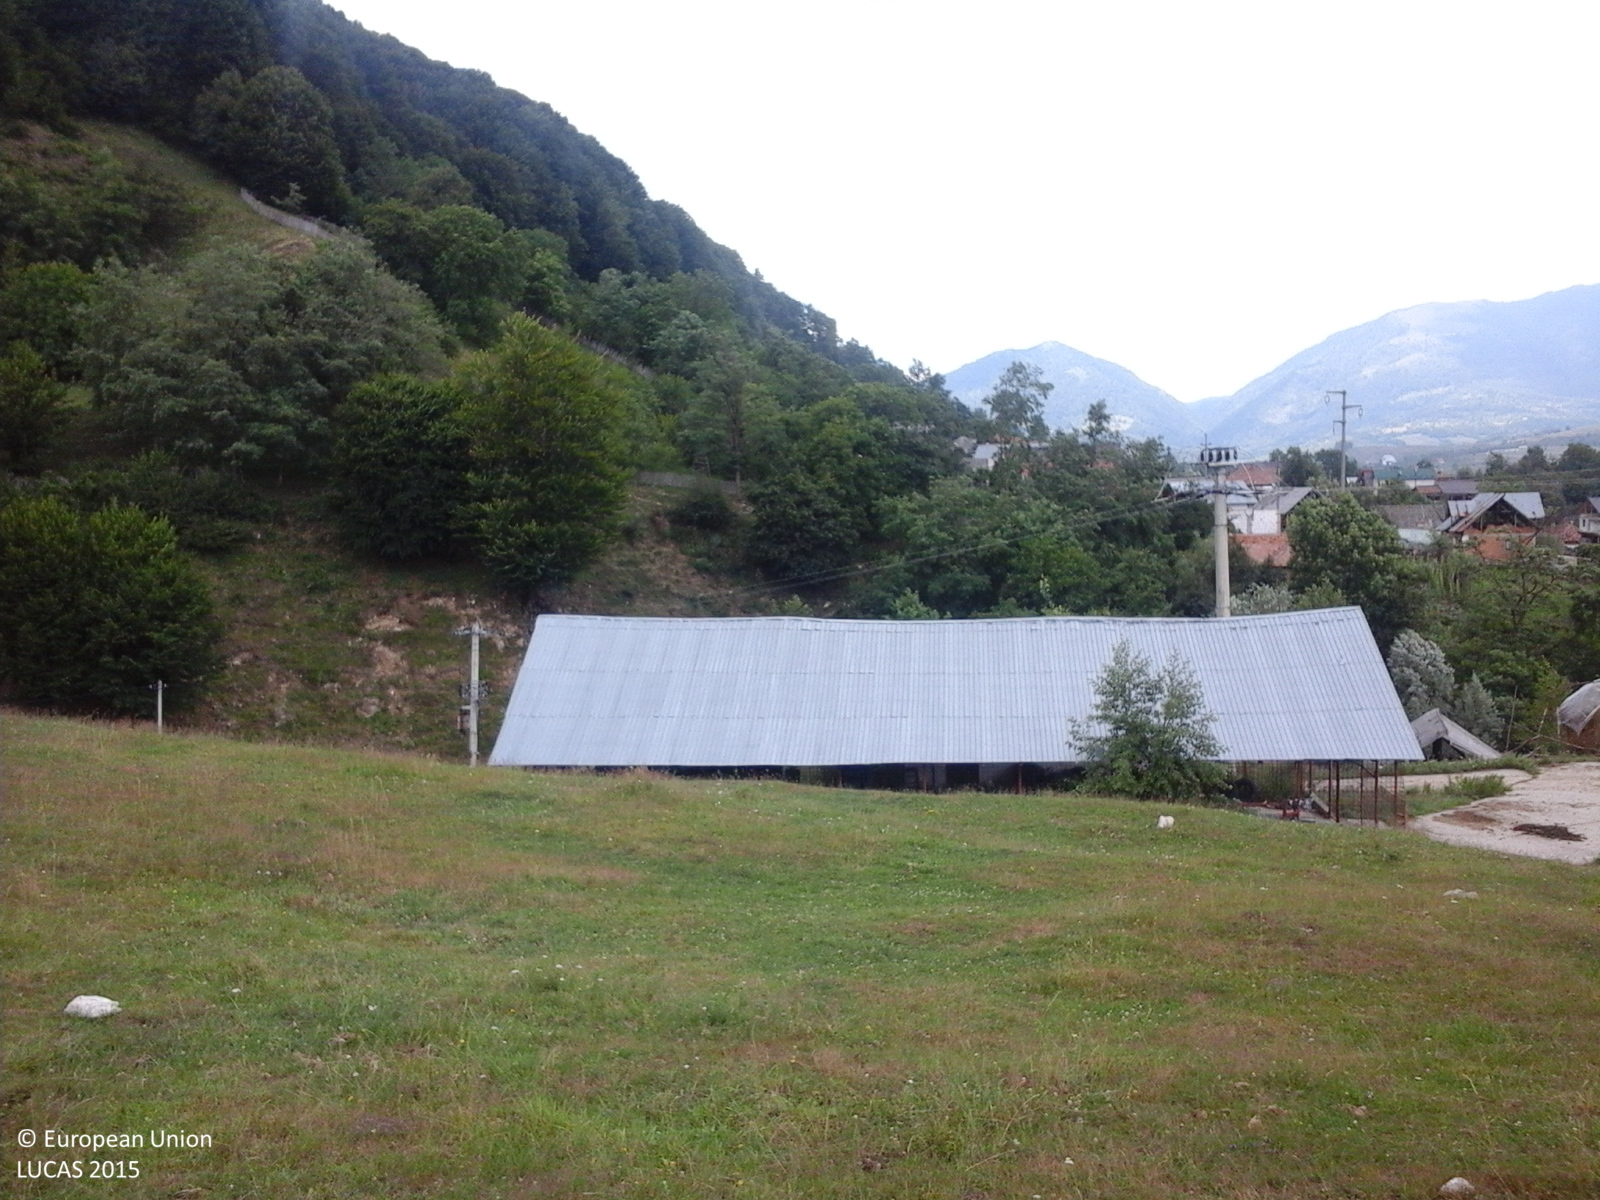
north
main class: Grassland
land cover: Grassland without tree/shrub cover
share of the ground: > 75 %
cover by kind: herbaceous plants 100 %
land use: Agriculture (excluding fallow land and kitchen gardens)
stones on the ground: < 10 %
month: July
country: RO
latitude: 45.2806
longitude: 24.6520
